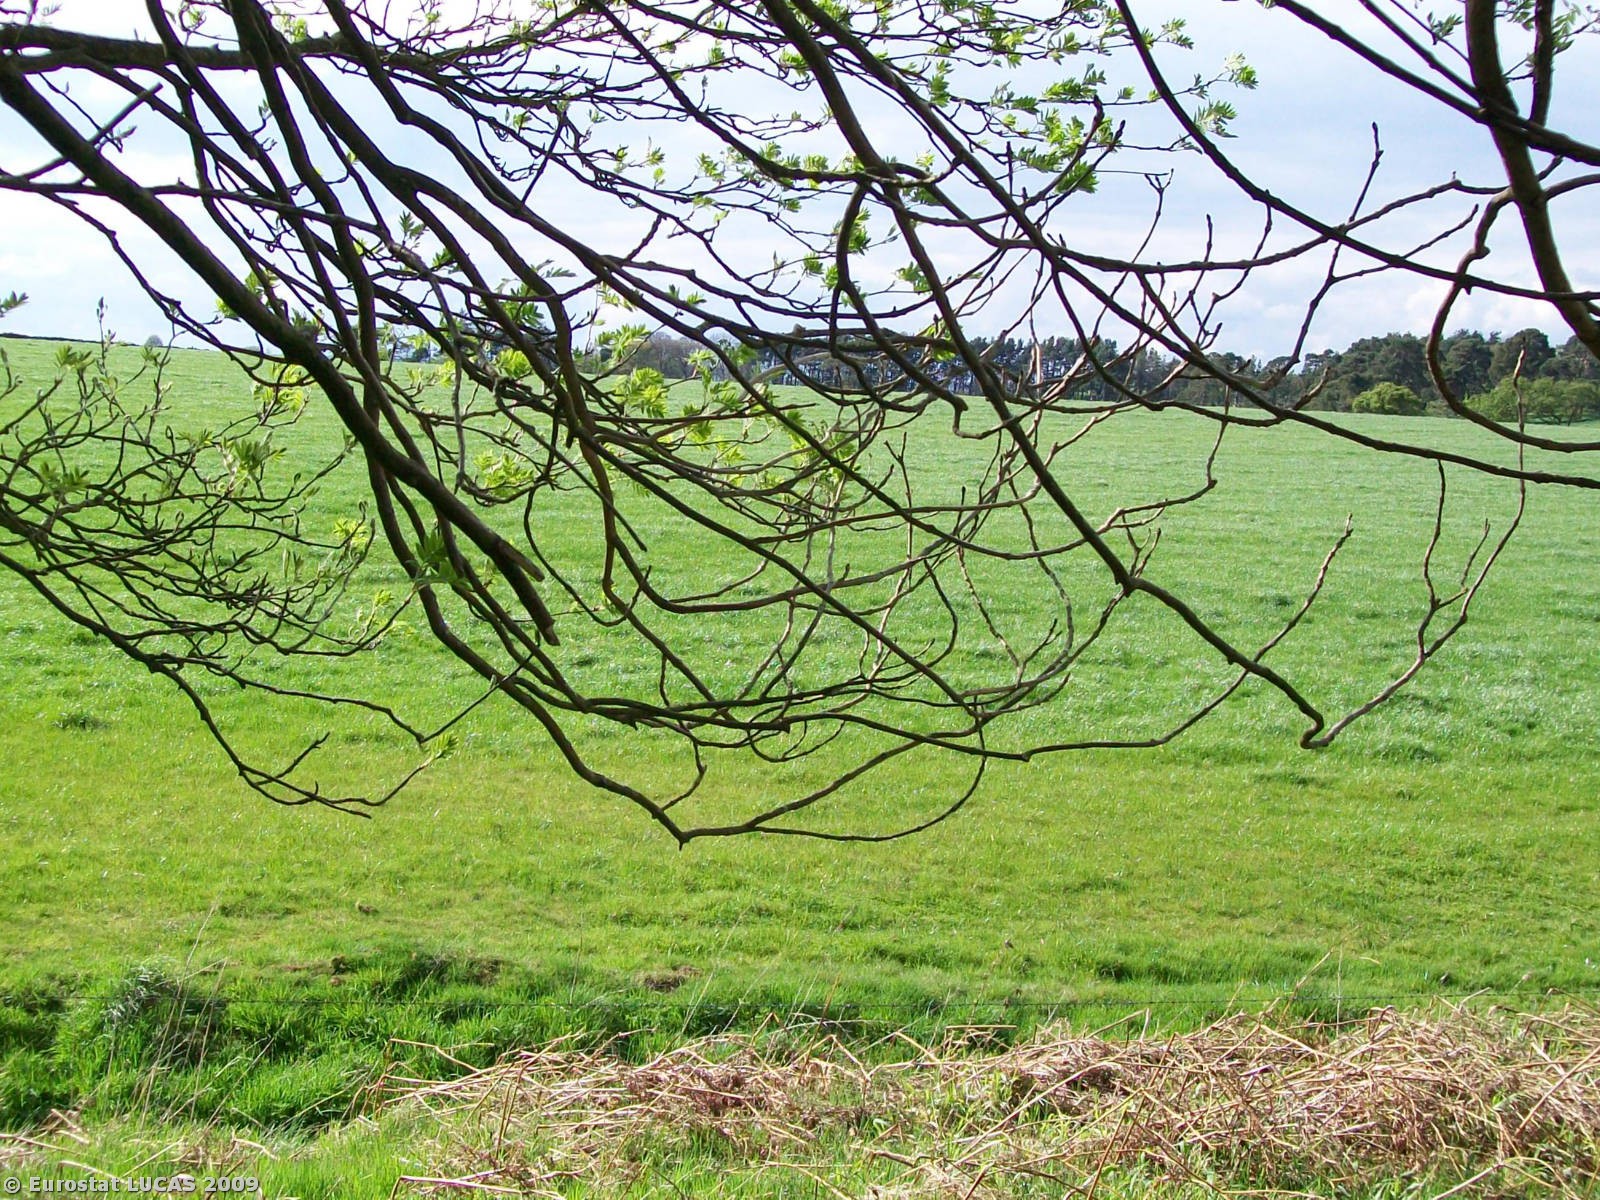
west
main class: Woodland
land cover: Broadleaved woodland
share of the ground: 50 - 75 %
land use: Unused
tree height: < 5 m
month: April
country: GB
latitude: 54.9077
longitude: -2.0498
